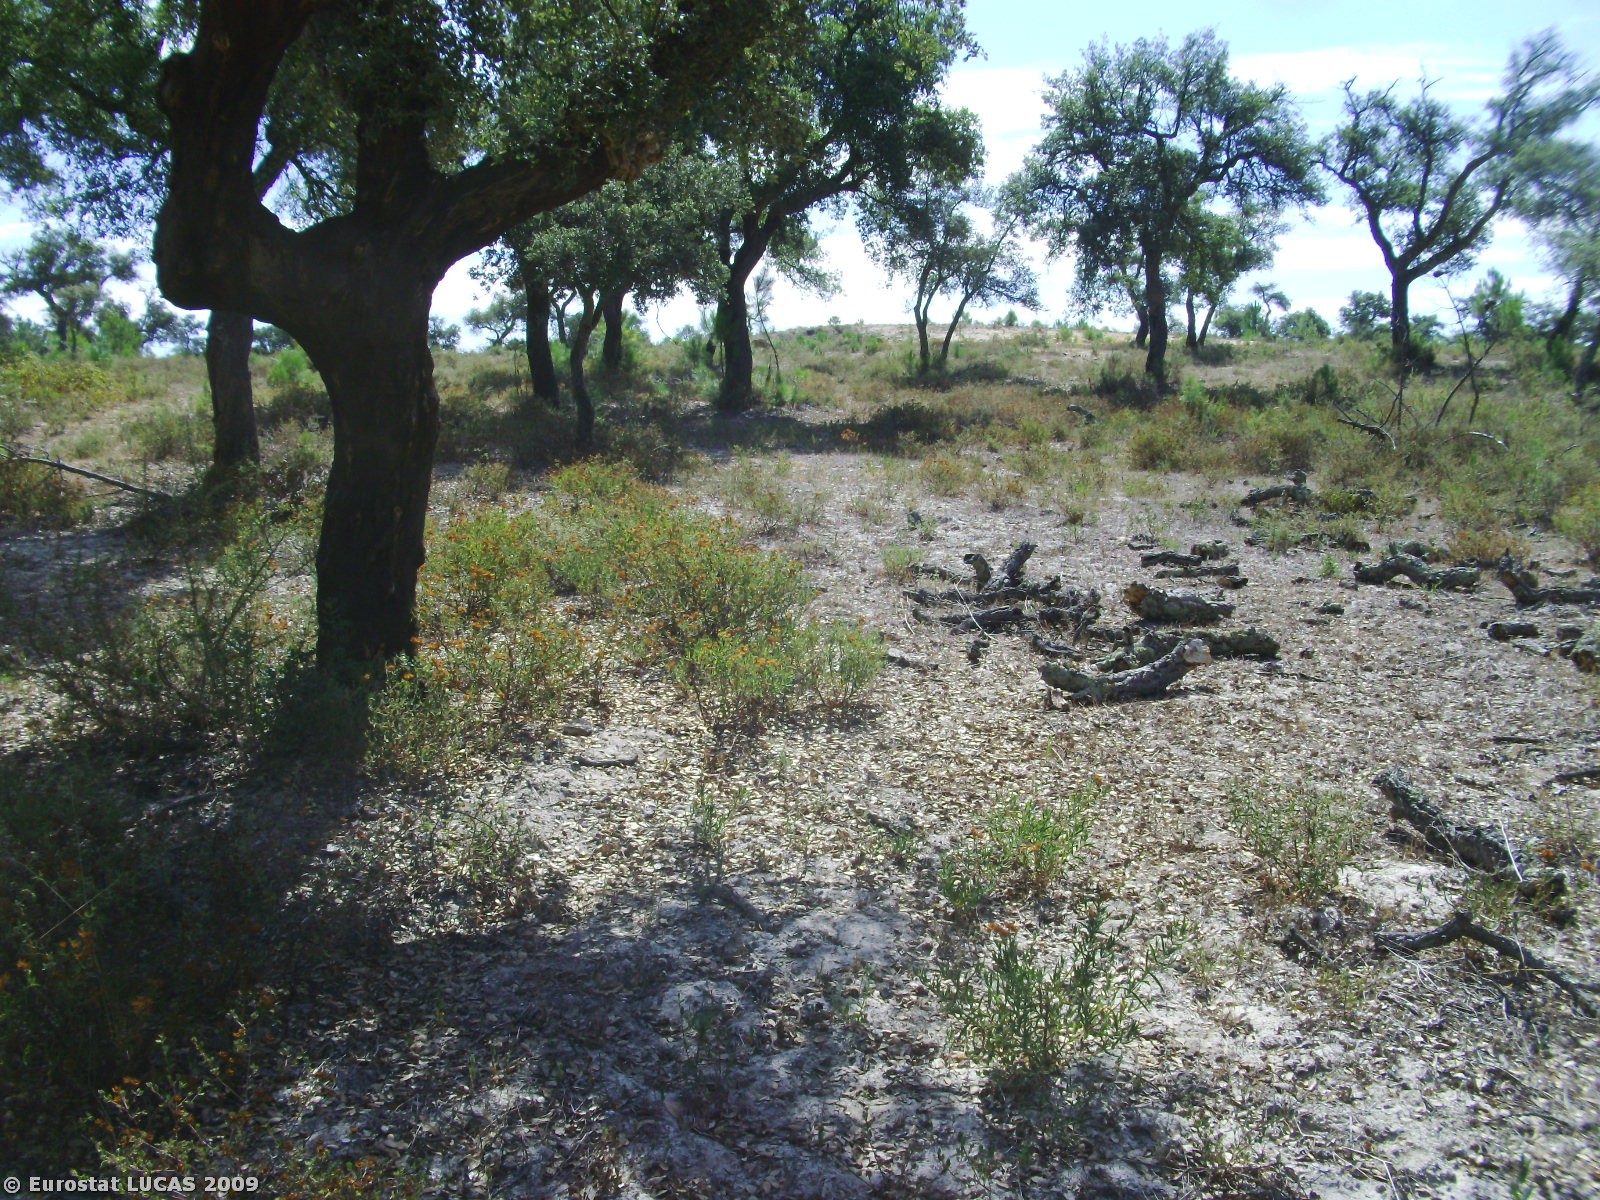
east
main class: Woodland
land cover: Broadleaved woodland
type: broadleaved evergreen forest
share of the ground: 25 - 50 %
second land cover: Spontaneously vegetated surfaces
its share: 50 - 75 %
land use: Forestry
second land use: Fallow land
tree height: > 5 m
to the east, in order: Broadleaved woodland; Spontaneously vegetated surfaces; Broadleaved woodland; Other structural elements; Broadleaved woodland; Tracks; Fences; Lines of trees; Paved roads, cycling and walking lanes; Shruby margins; Fences; Lines of trees; Tracks; Broadleaved woodland; Tracks; Broadleaved woodland
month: August
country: PT
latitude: 38.5694
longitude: -8.6637
